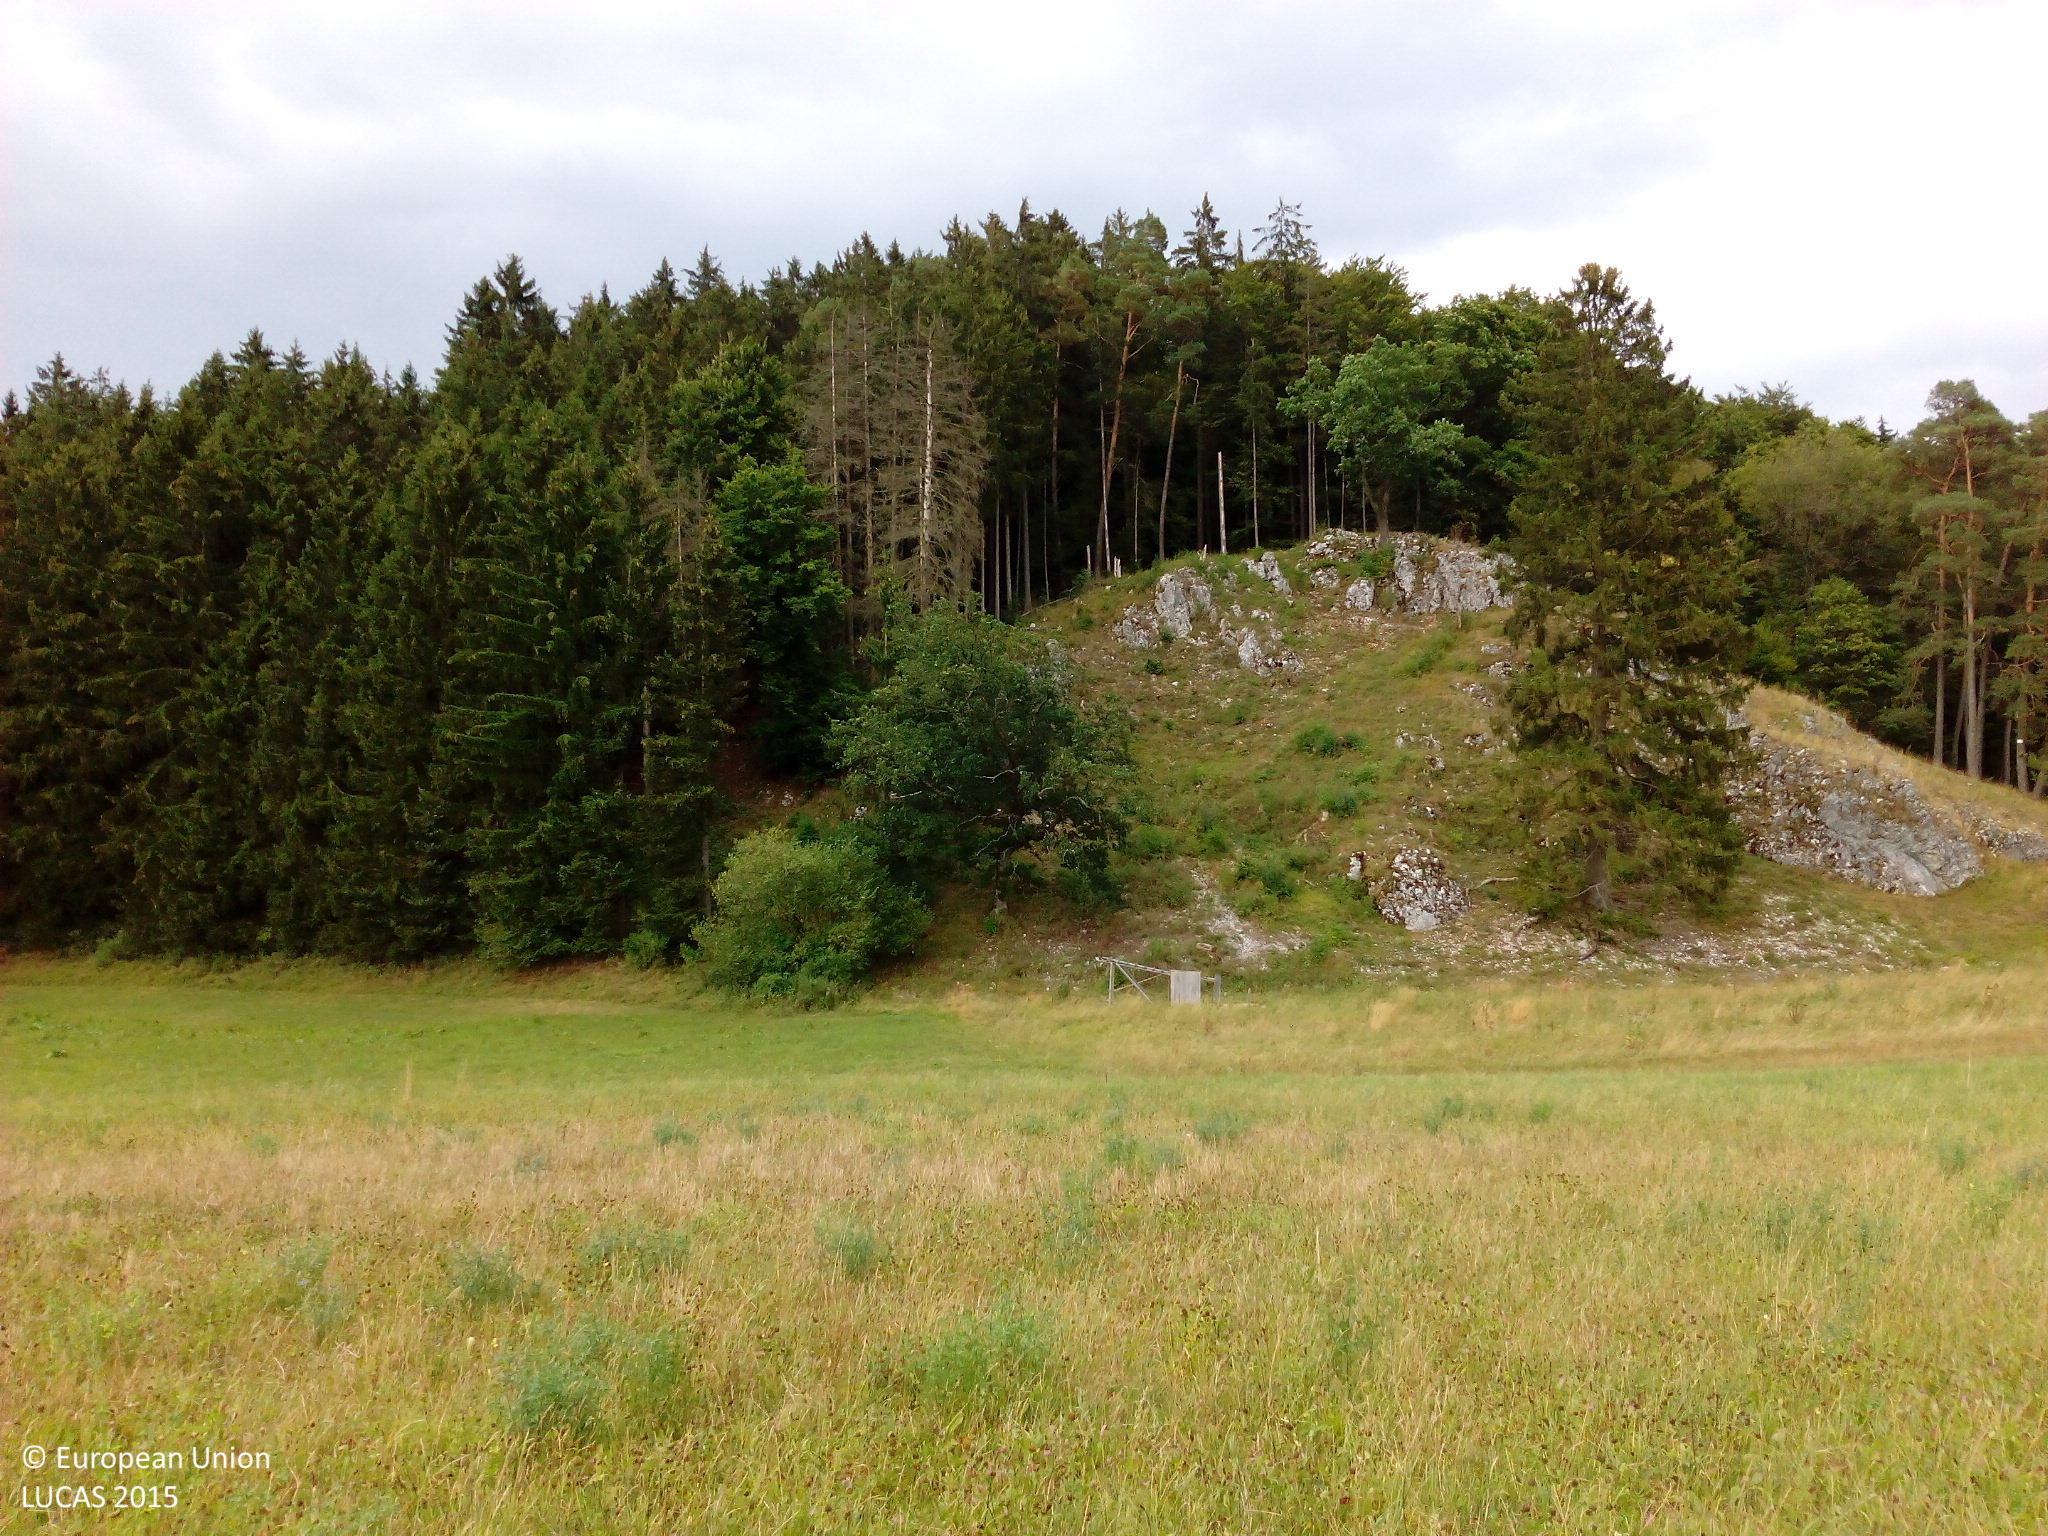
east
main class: Grassland
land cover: Grassland without tree/shrub cover
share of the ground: > 75 %
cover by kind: herbaceous plants 95 %, unconsolidated bare surface 5 %
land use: Agriculture (excluding fallow land and kitchen gardens)
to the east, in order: Grassland without tree/shrub cover; Tracks; Grassland without tree/shrub cover; Single bushes/trees; Rocks and stones; Spruce dominated coniferous woodland; Broadleaved woodland; Tracks; Broadleaved woodland; Tracks; Spruce dominated mixed woodland; Tracks; Broadleaved woodland
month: August
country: DE
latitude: 48.6194
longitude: 9.9593
